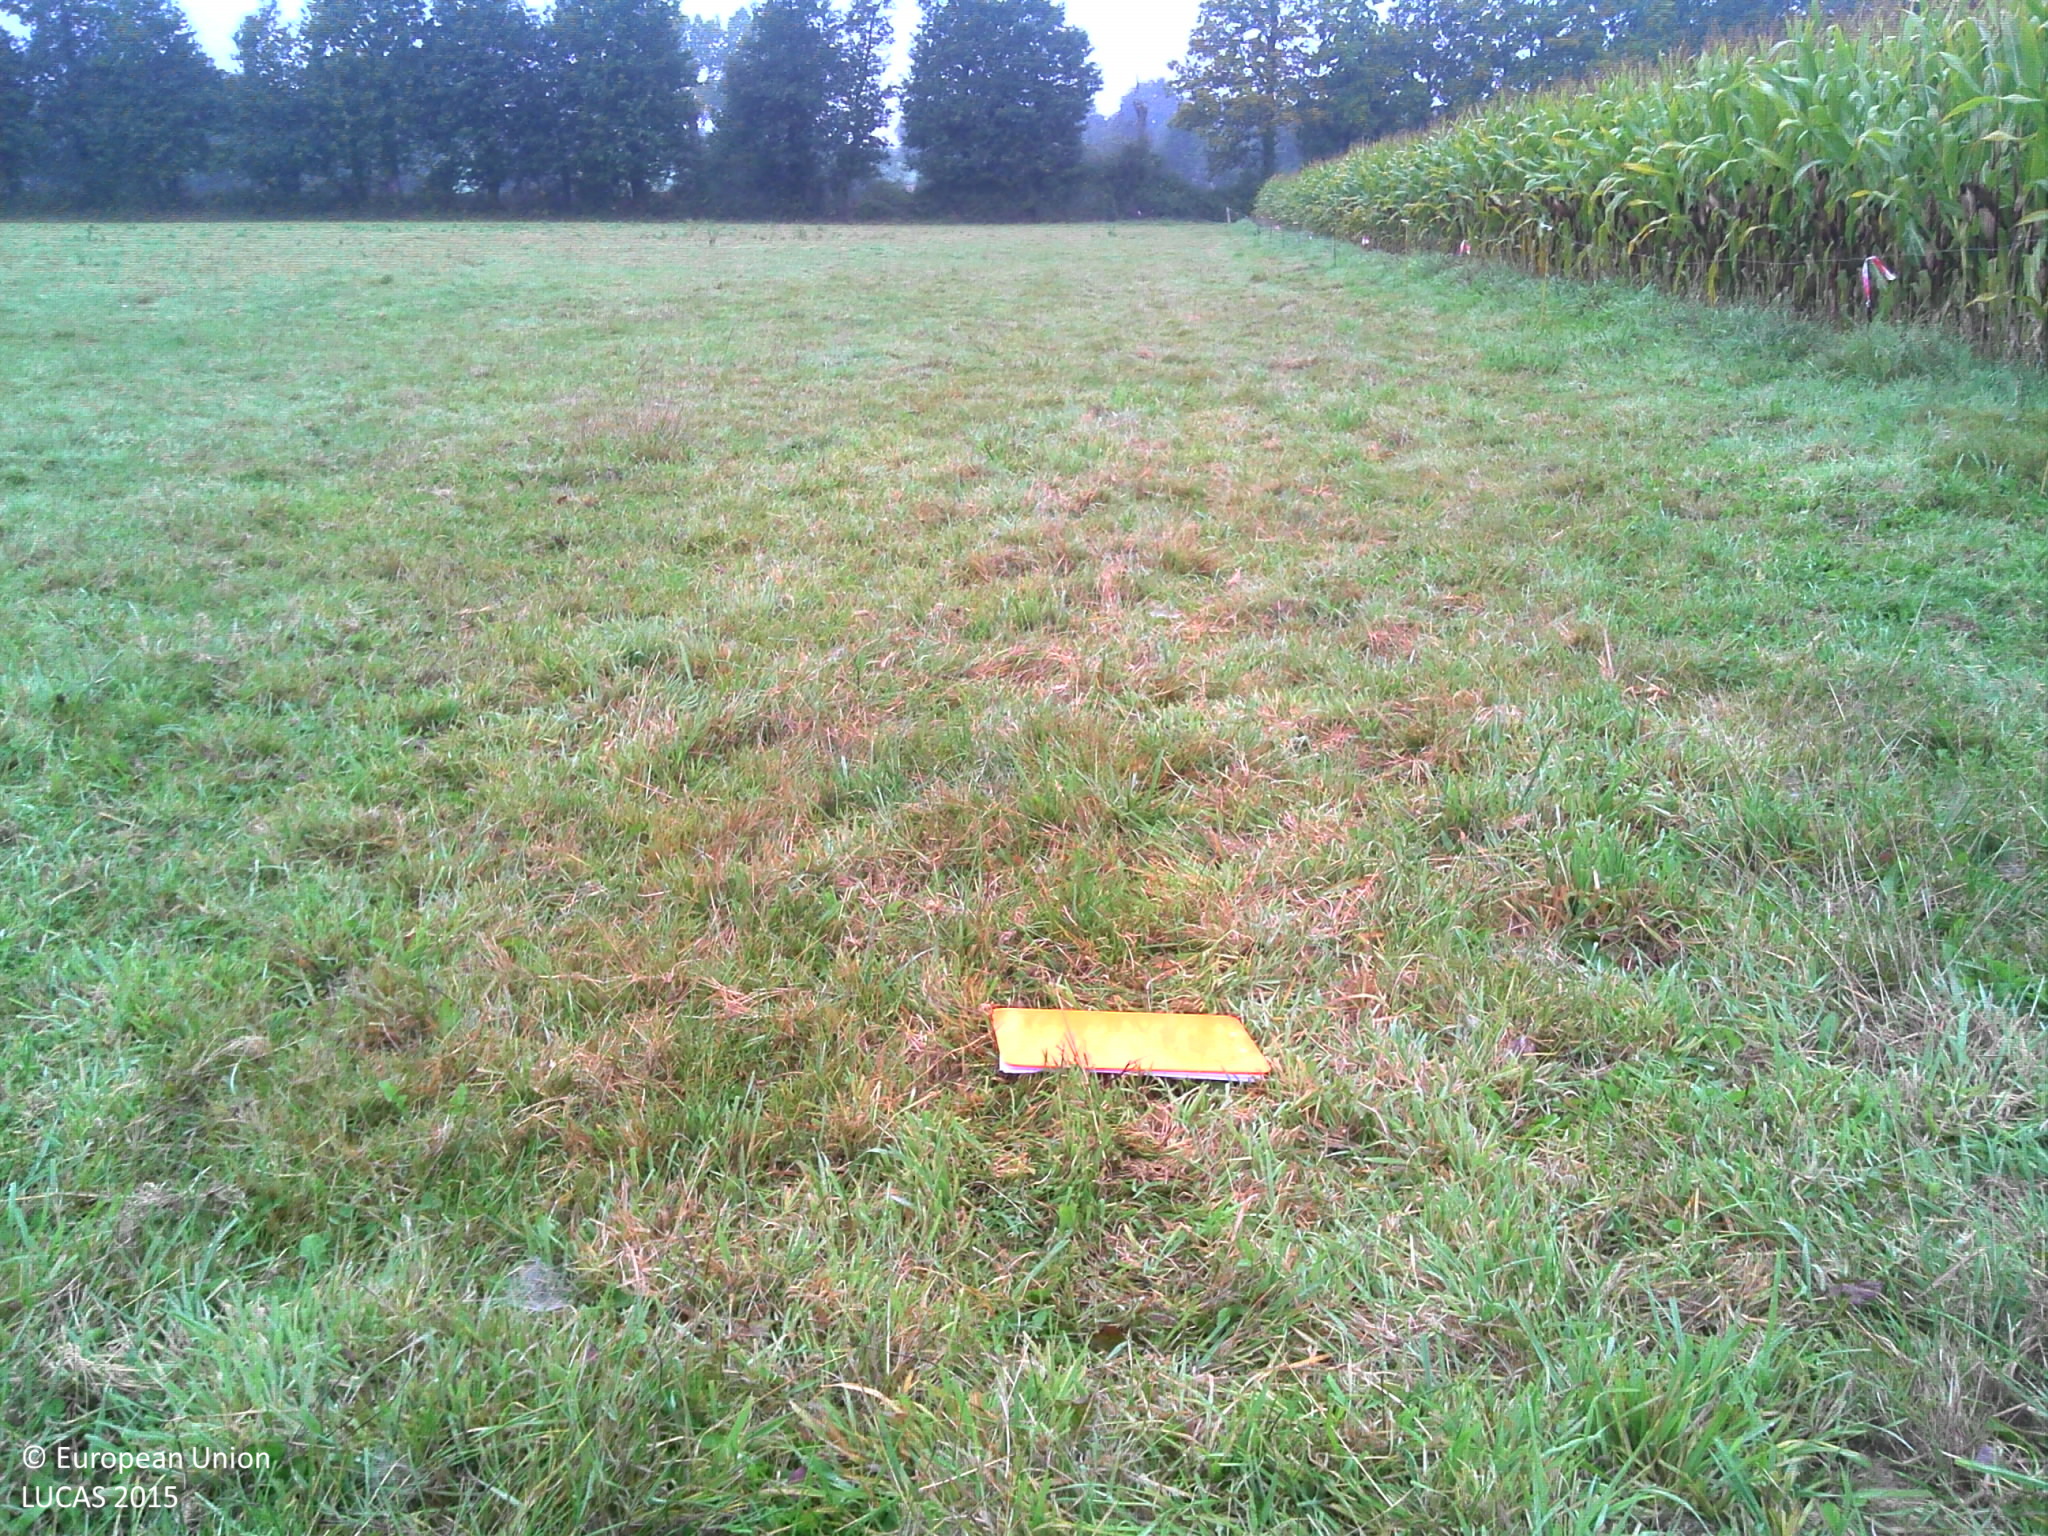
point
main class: Grassland
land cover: Grassland without tree/shrub cover
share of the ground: > 75 %
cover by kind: herbaceous plants 100 %
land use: Agriculture (excluding fallow land and kitchen gardens)
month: October
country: FR
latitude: 47.9434
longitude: -2.3607
